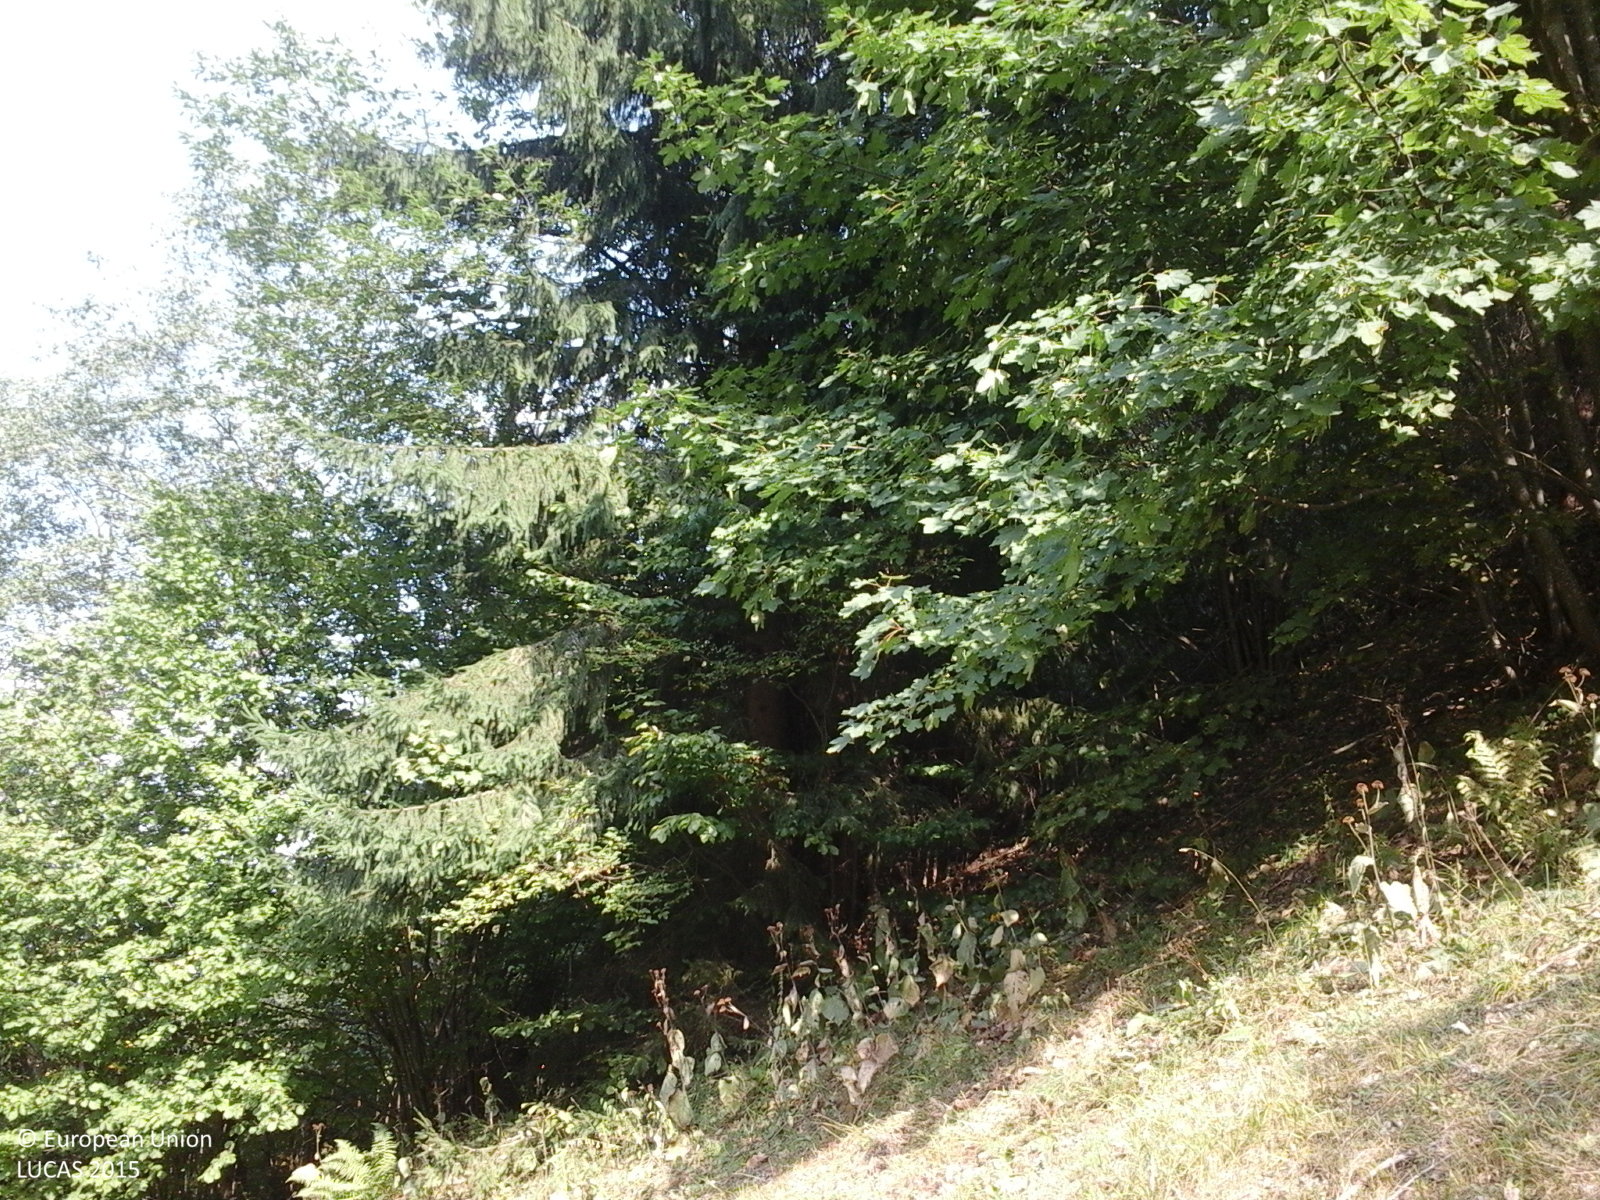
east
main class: Grassland
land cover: Grassland without tree/shrub cover
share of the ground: > 75 %
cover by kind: herbaceous plants 100 %
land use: Agriculture (excluding fallow land and kitchen gardens)
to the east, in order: Grassland without tree/shrub cover; Fences; Broadleaved woodland; Grassland without tree/shrub cover; Broadleaved woodland; Grassland without tree/shrub cover; Broadleaved woodland; Grassland without tree/shrub cover
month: September
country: RO
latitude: 47.7993
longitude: 24.4193
